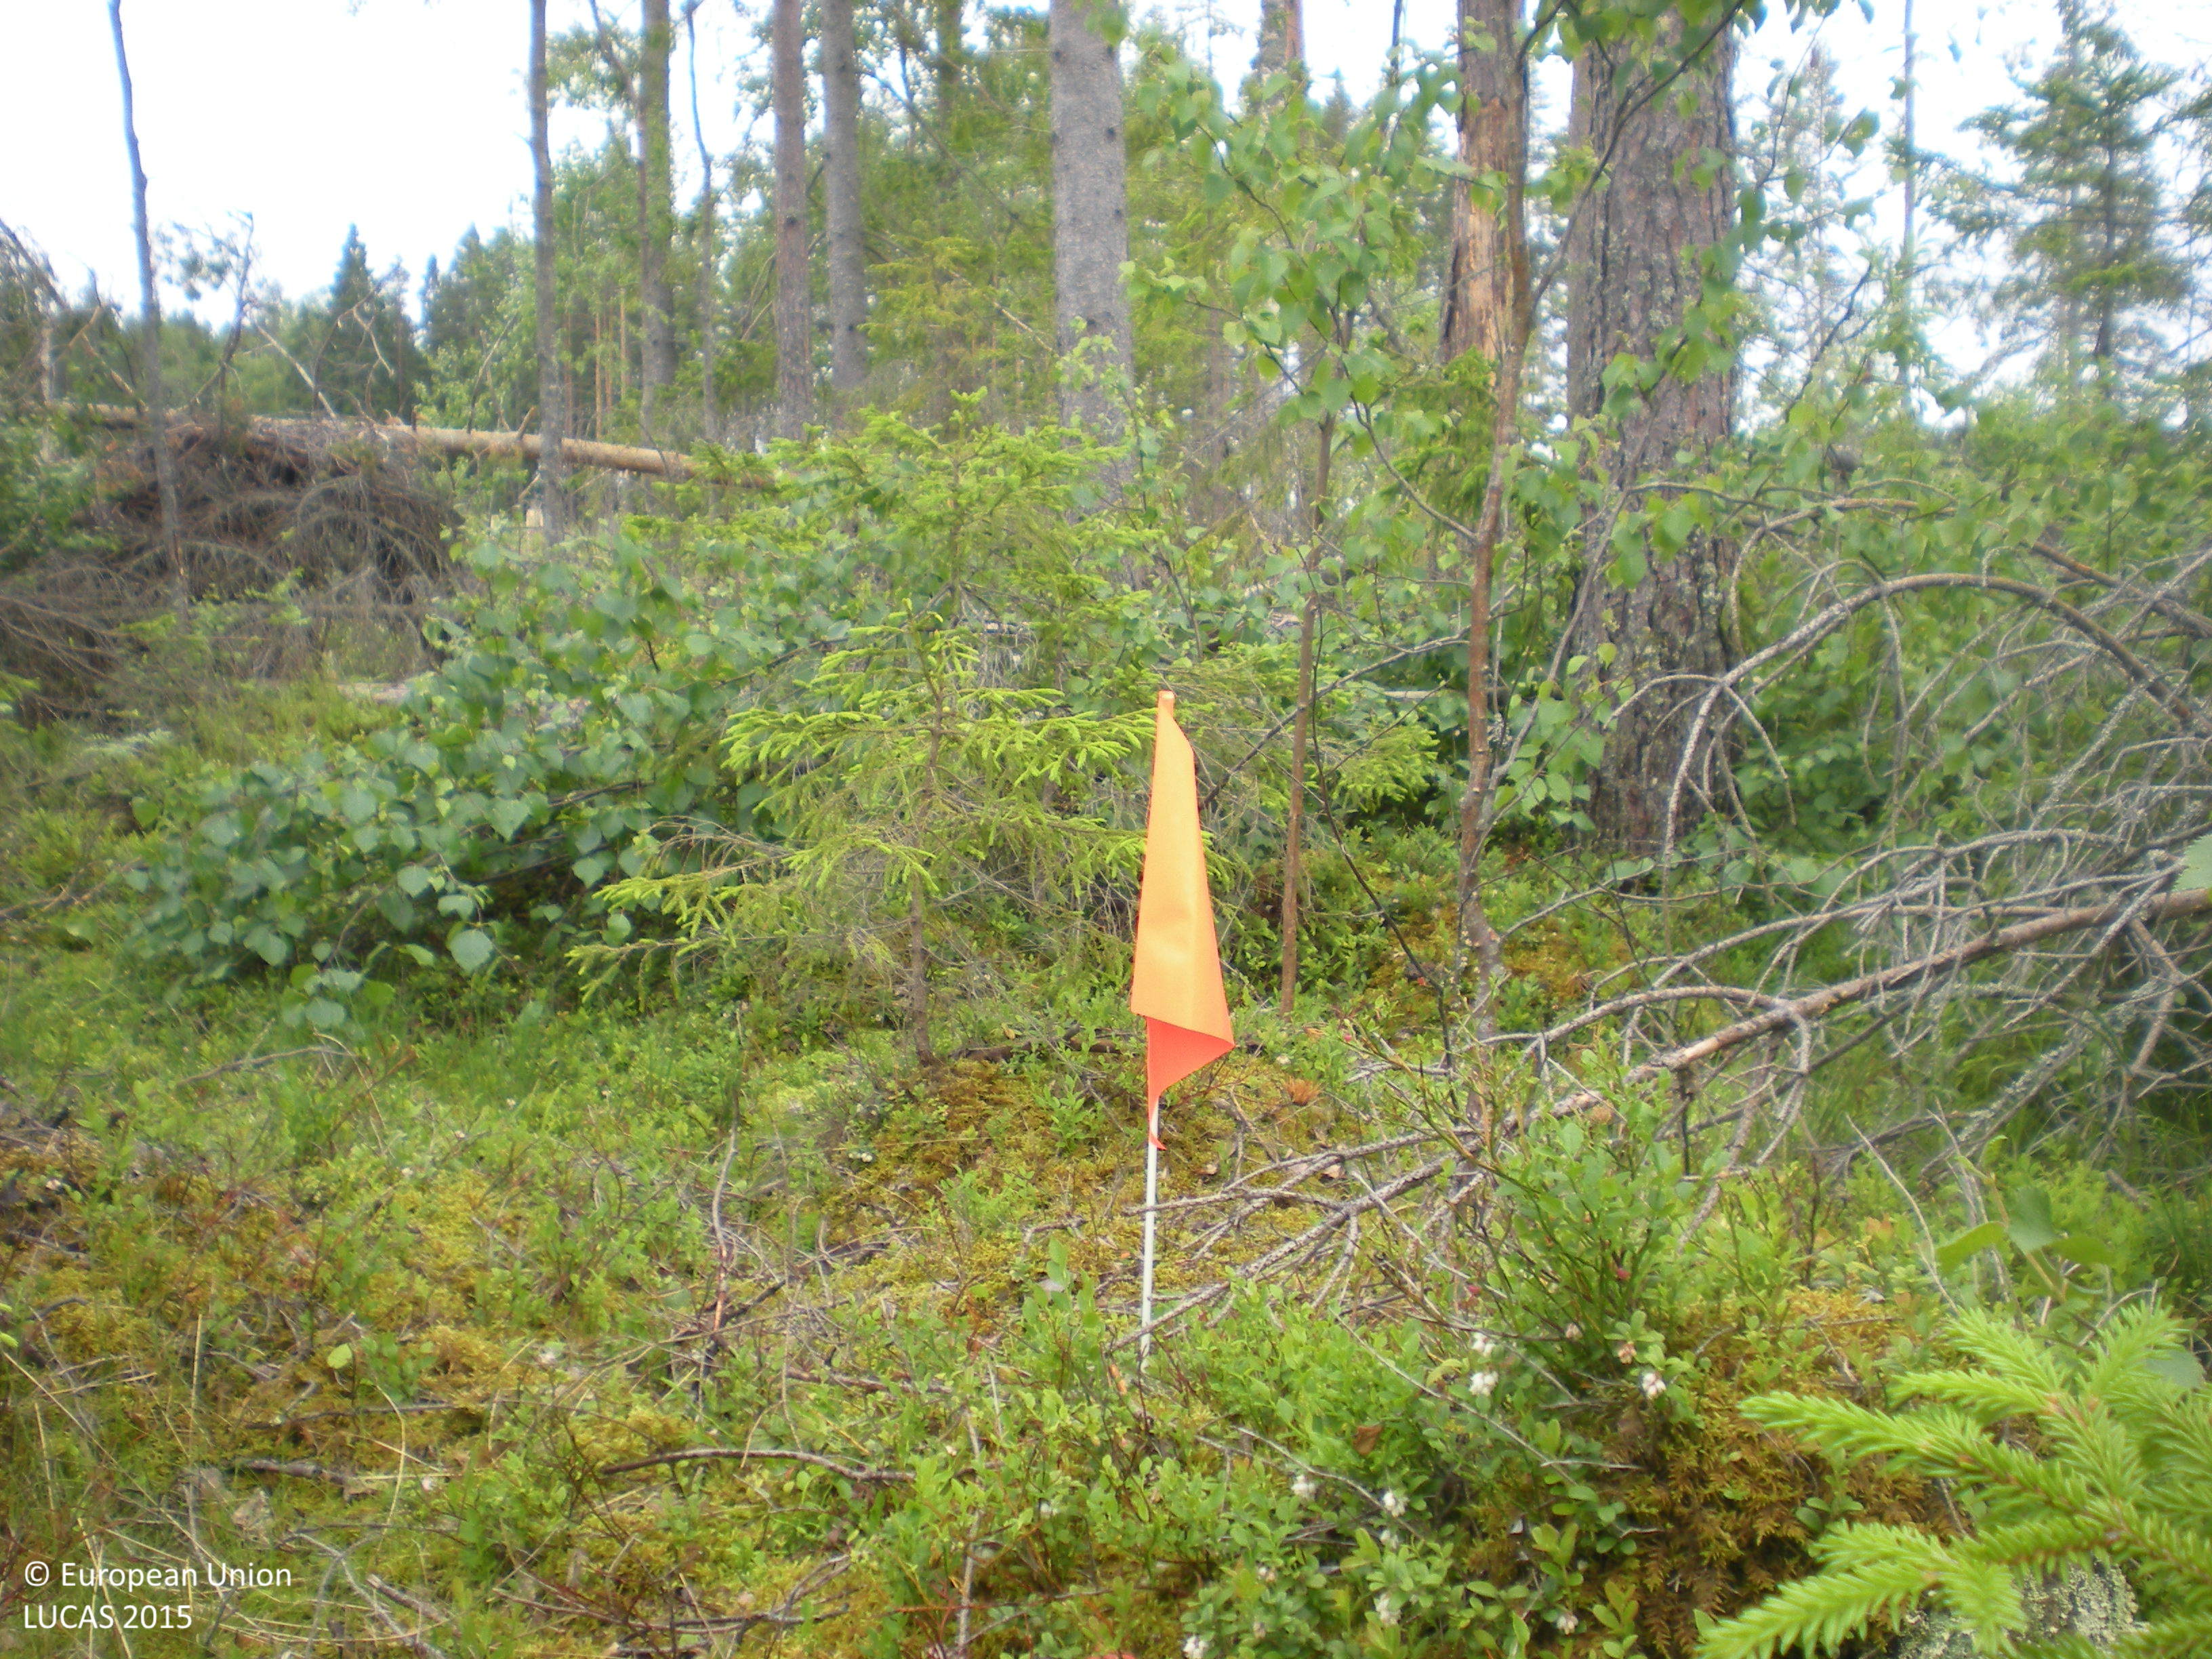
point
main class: Woodland
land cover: Other coniferous woodland
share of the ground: 50 - 75 %
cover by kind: coniferous forest trees 45 %, broadleaved forest trees 15 %, shrubs 15 %, lichens and mosses 15 %, herbaceous plants 5 %
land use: Forestry
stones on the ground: < 10 %
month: June
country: SE
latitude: 60.3824
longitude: 17.7744
